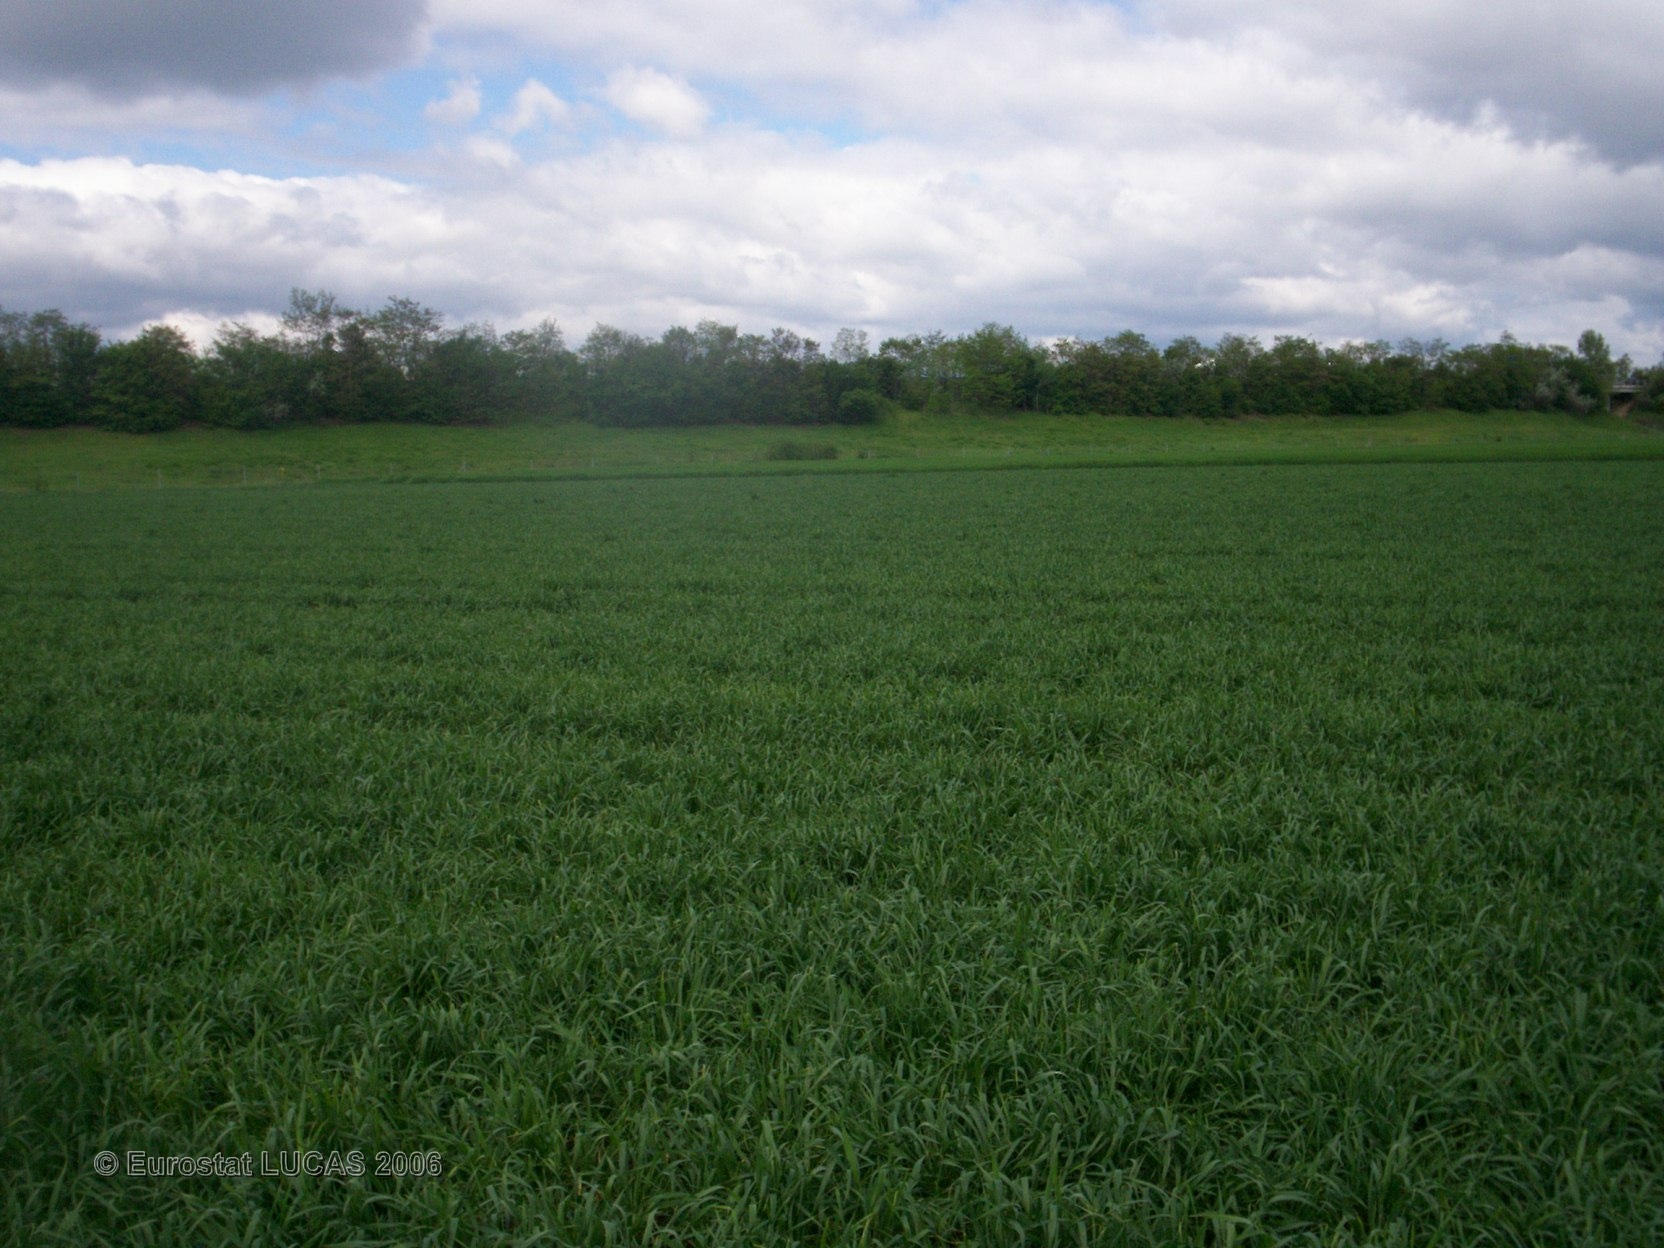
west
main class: Cropland
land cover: Barley
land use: Agriculture (excluding fallow land and kitchen gardens)
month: May
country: FR
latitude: 45.9148
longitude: 3.1535
